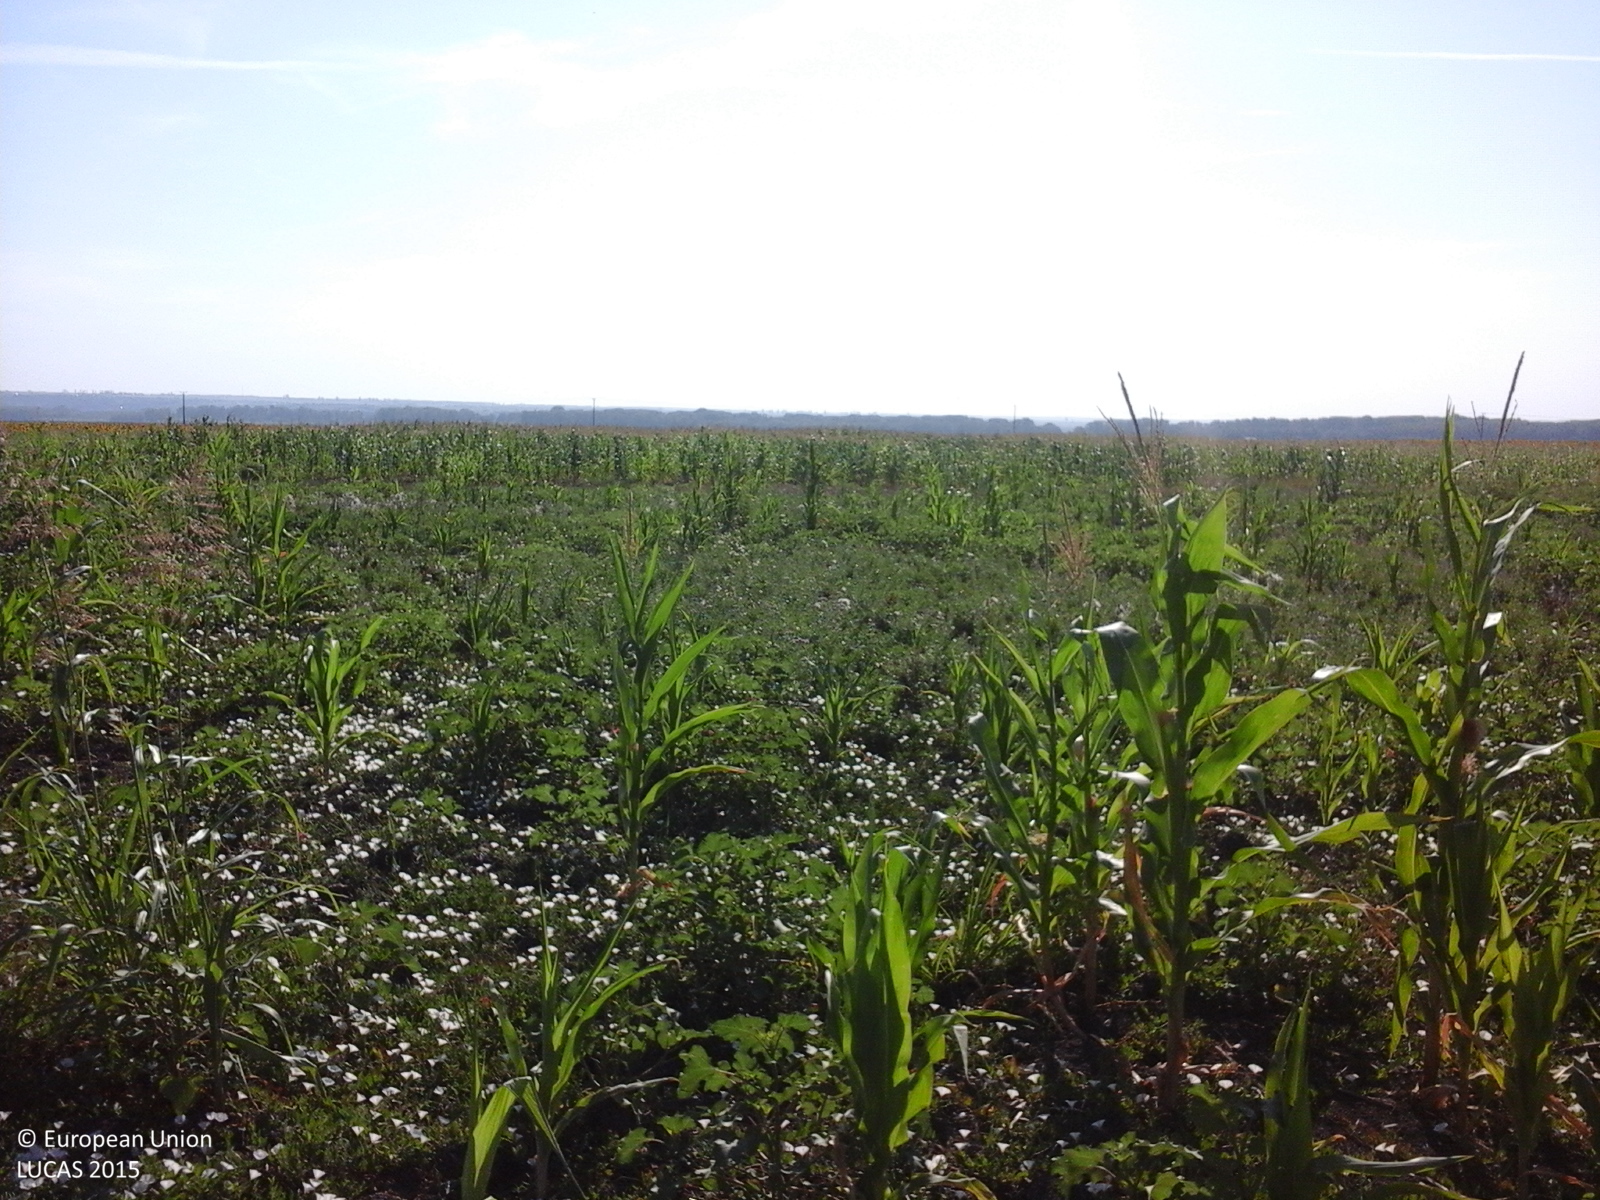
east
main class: Cropland
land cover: Maize
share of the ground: 50 - 75 %
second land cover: Spontaneously vegetated surfaces
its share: 25 - 50 %
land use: Agriculture (excluding fallow land and kitchen gardens)
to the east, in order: Maize; Spontaneously vegetated surfaces; Tracks; Maize
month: July
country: RO
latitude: 46.5444
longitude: 28.1947
